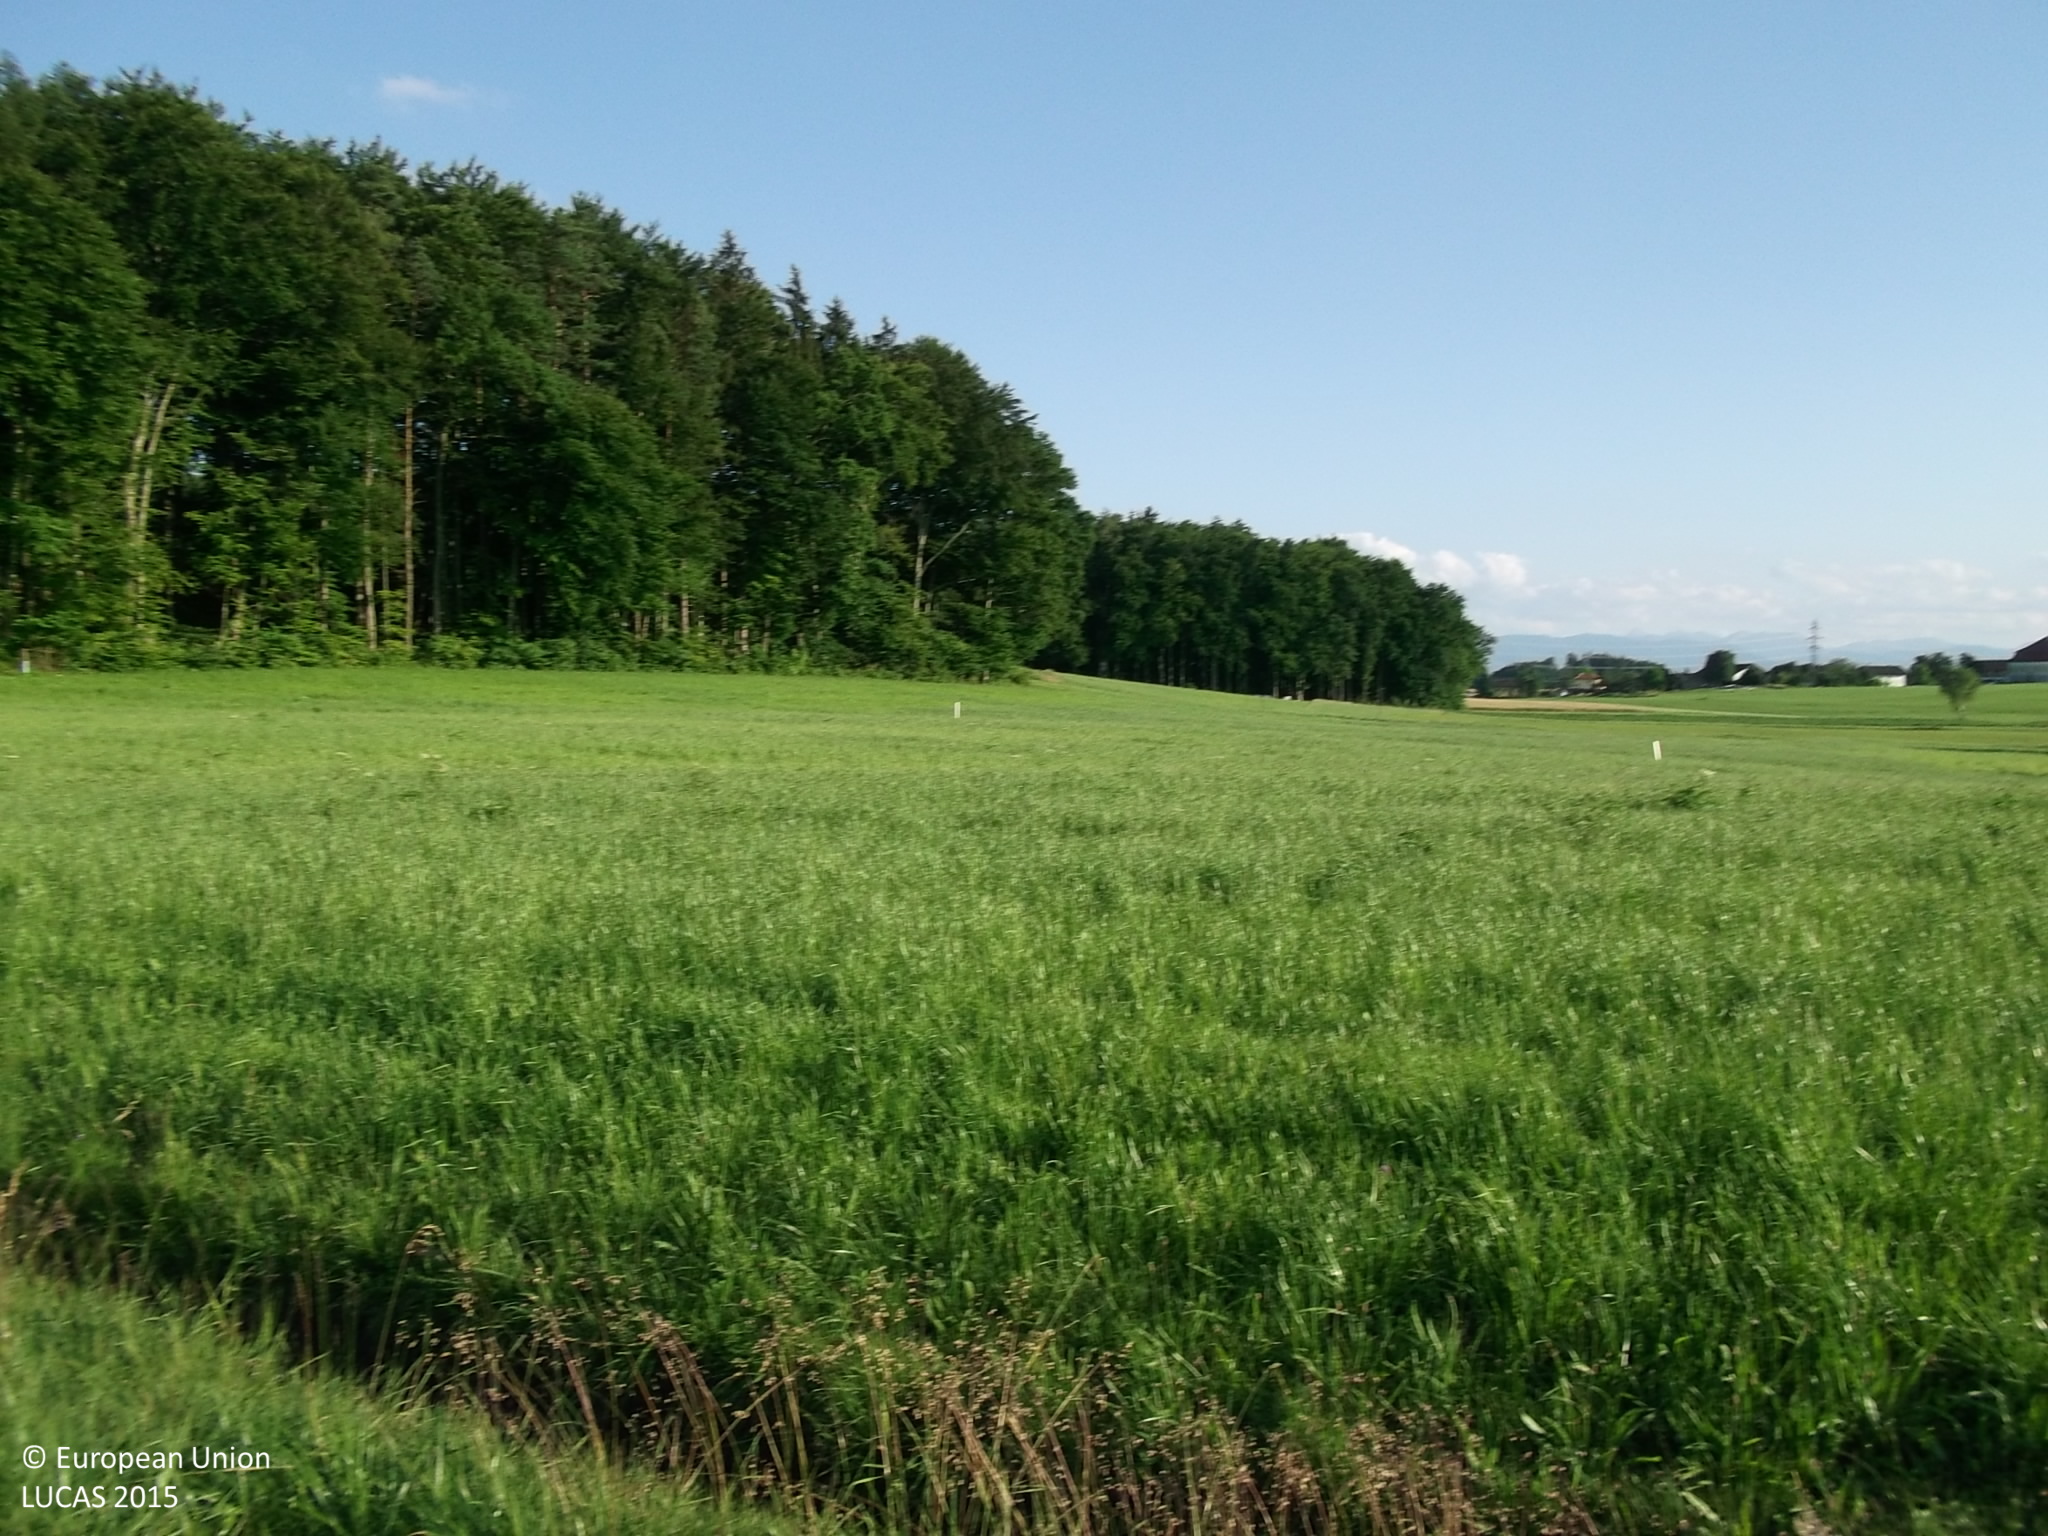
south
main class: Grassland
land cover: Grassland without tree/shrub cover
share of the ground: > 75 %
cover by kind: herbaceous plants 100 %
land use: Agriculture (excluding fallow land and kitchen gardens)
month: June
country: AT
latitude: 48.0418
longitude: 12.8827
